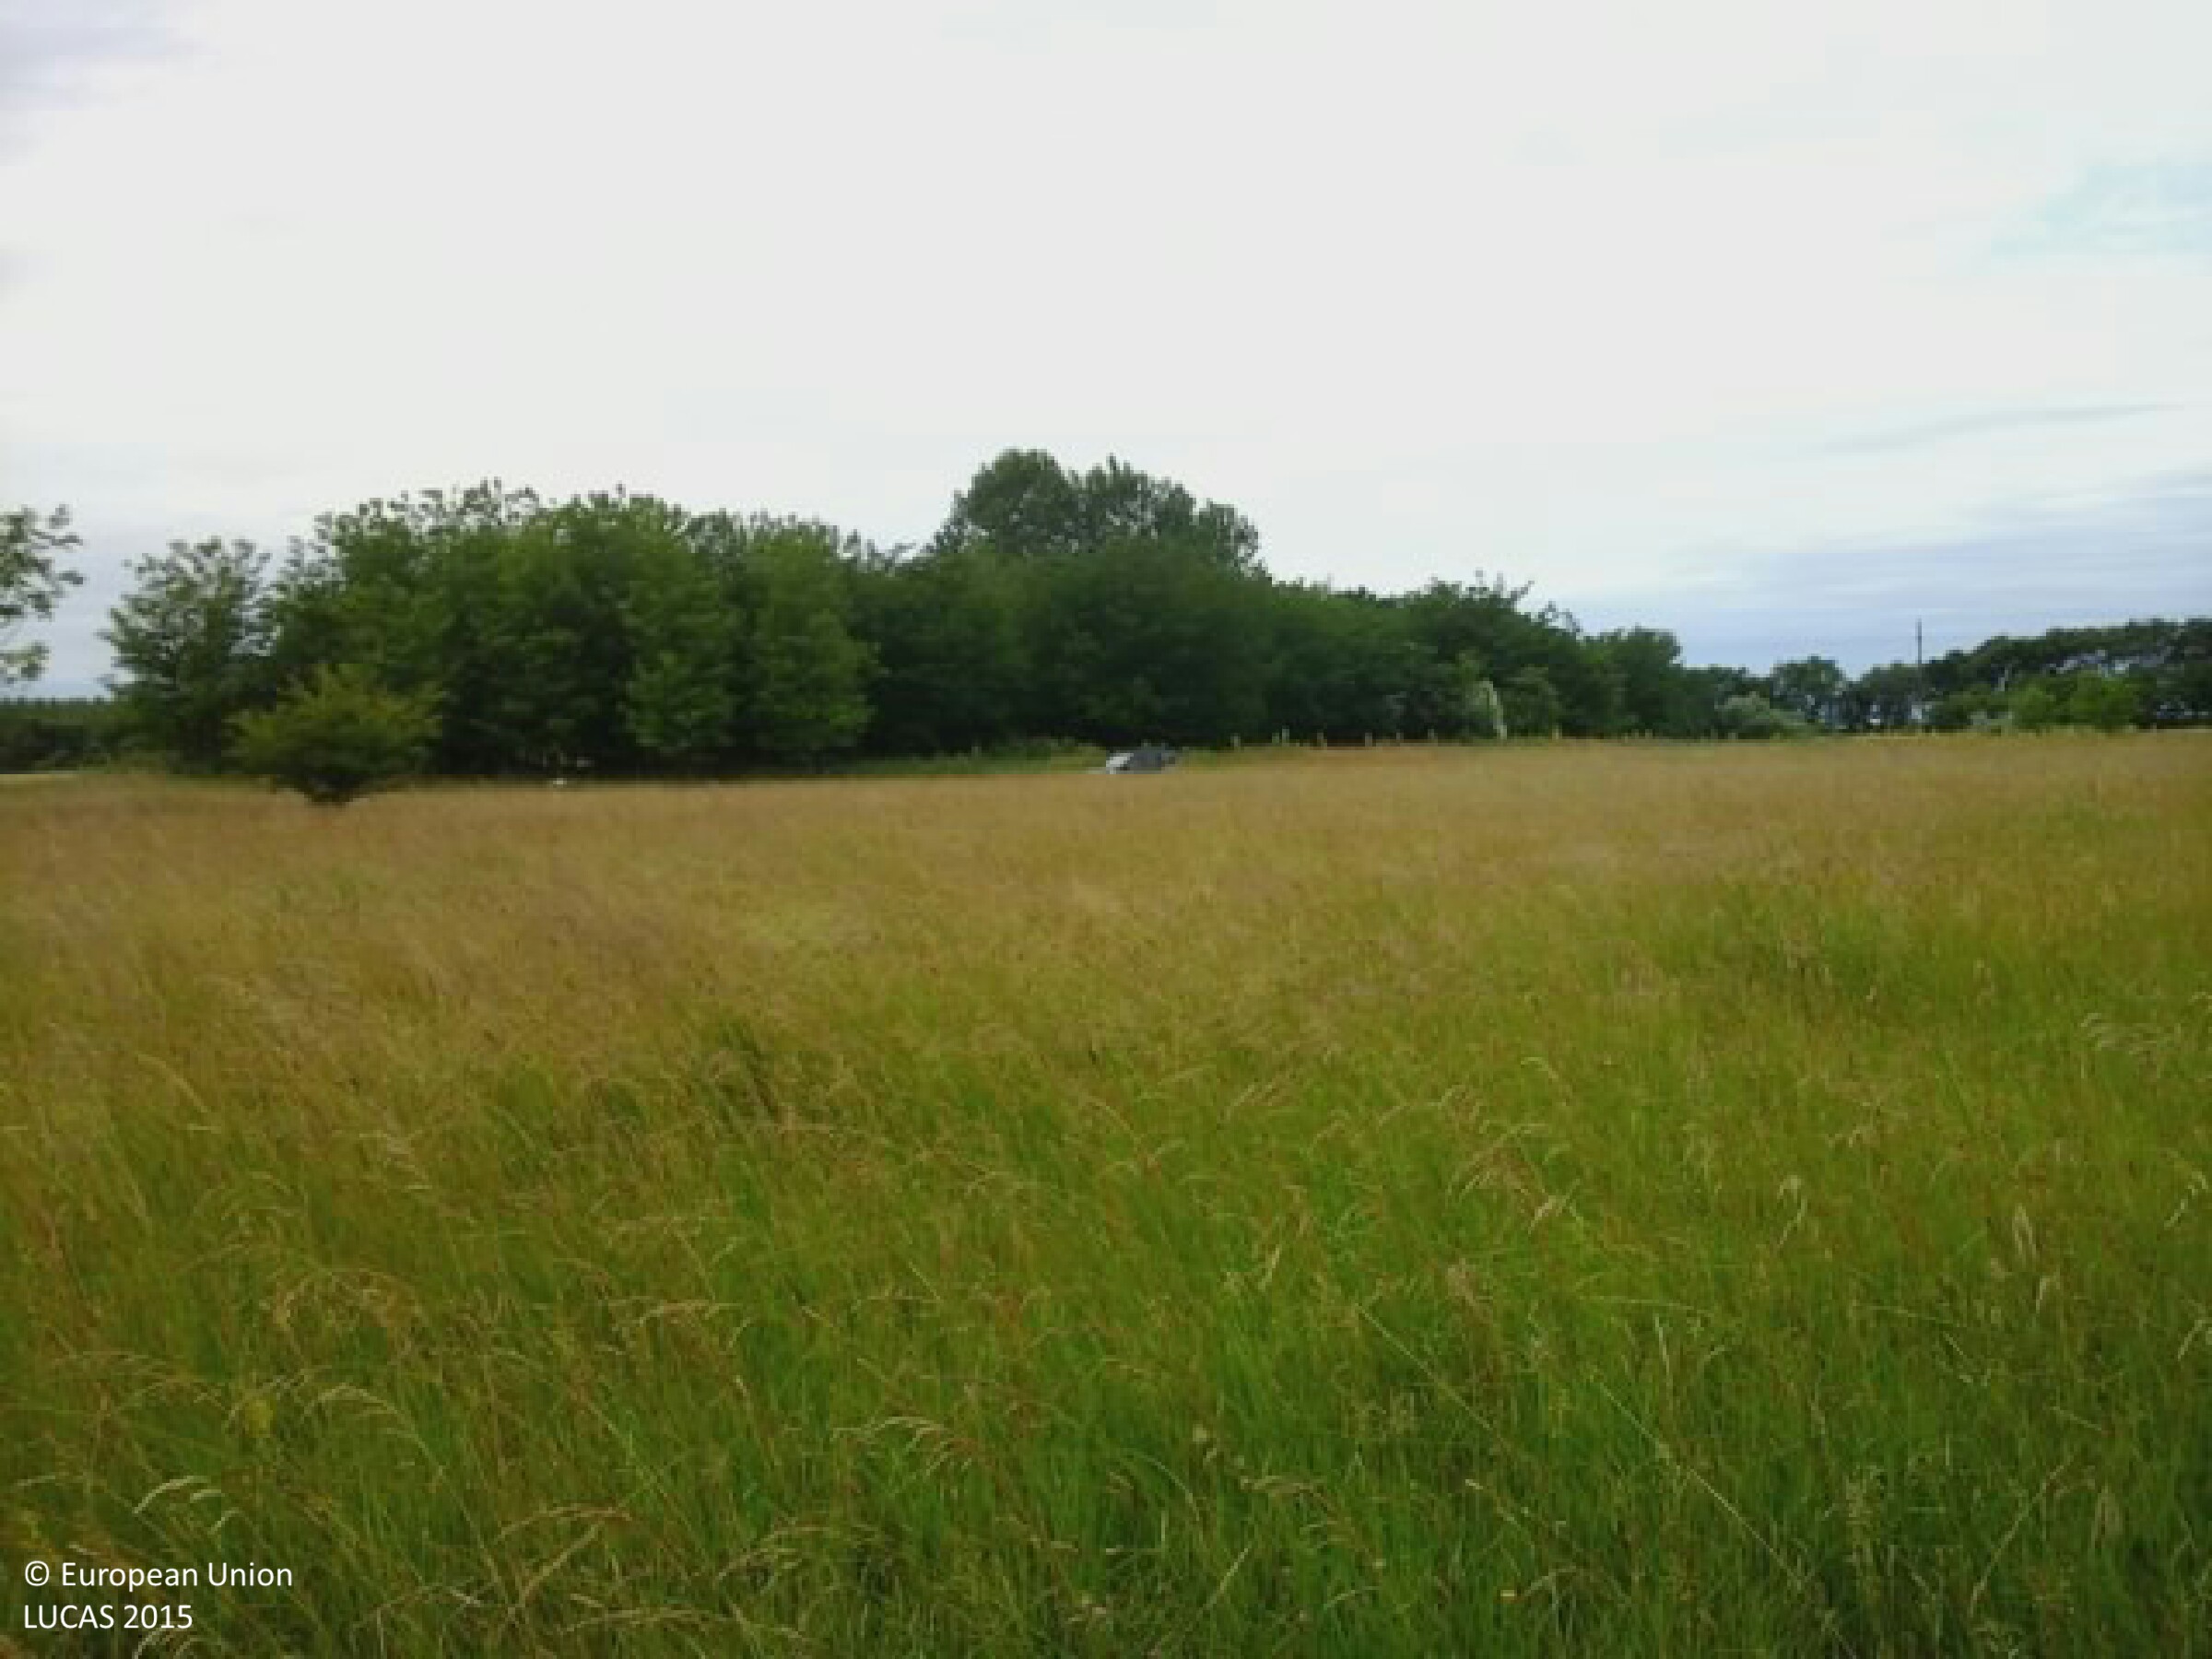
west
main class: Grassland
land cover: Grassland without tree/shrub cover
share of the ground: > 75 %
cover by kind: herbaceous plants 100 %
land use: Agriculture (excluding fallow land and kitchen gardens)
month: June
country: HU
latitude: 46.7201
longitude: 19.5564
